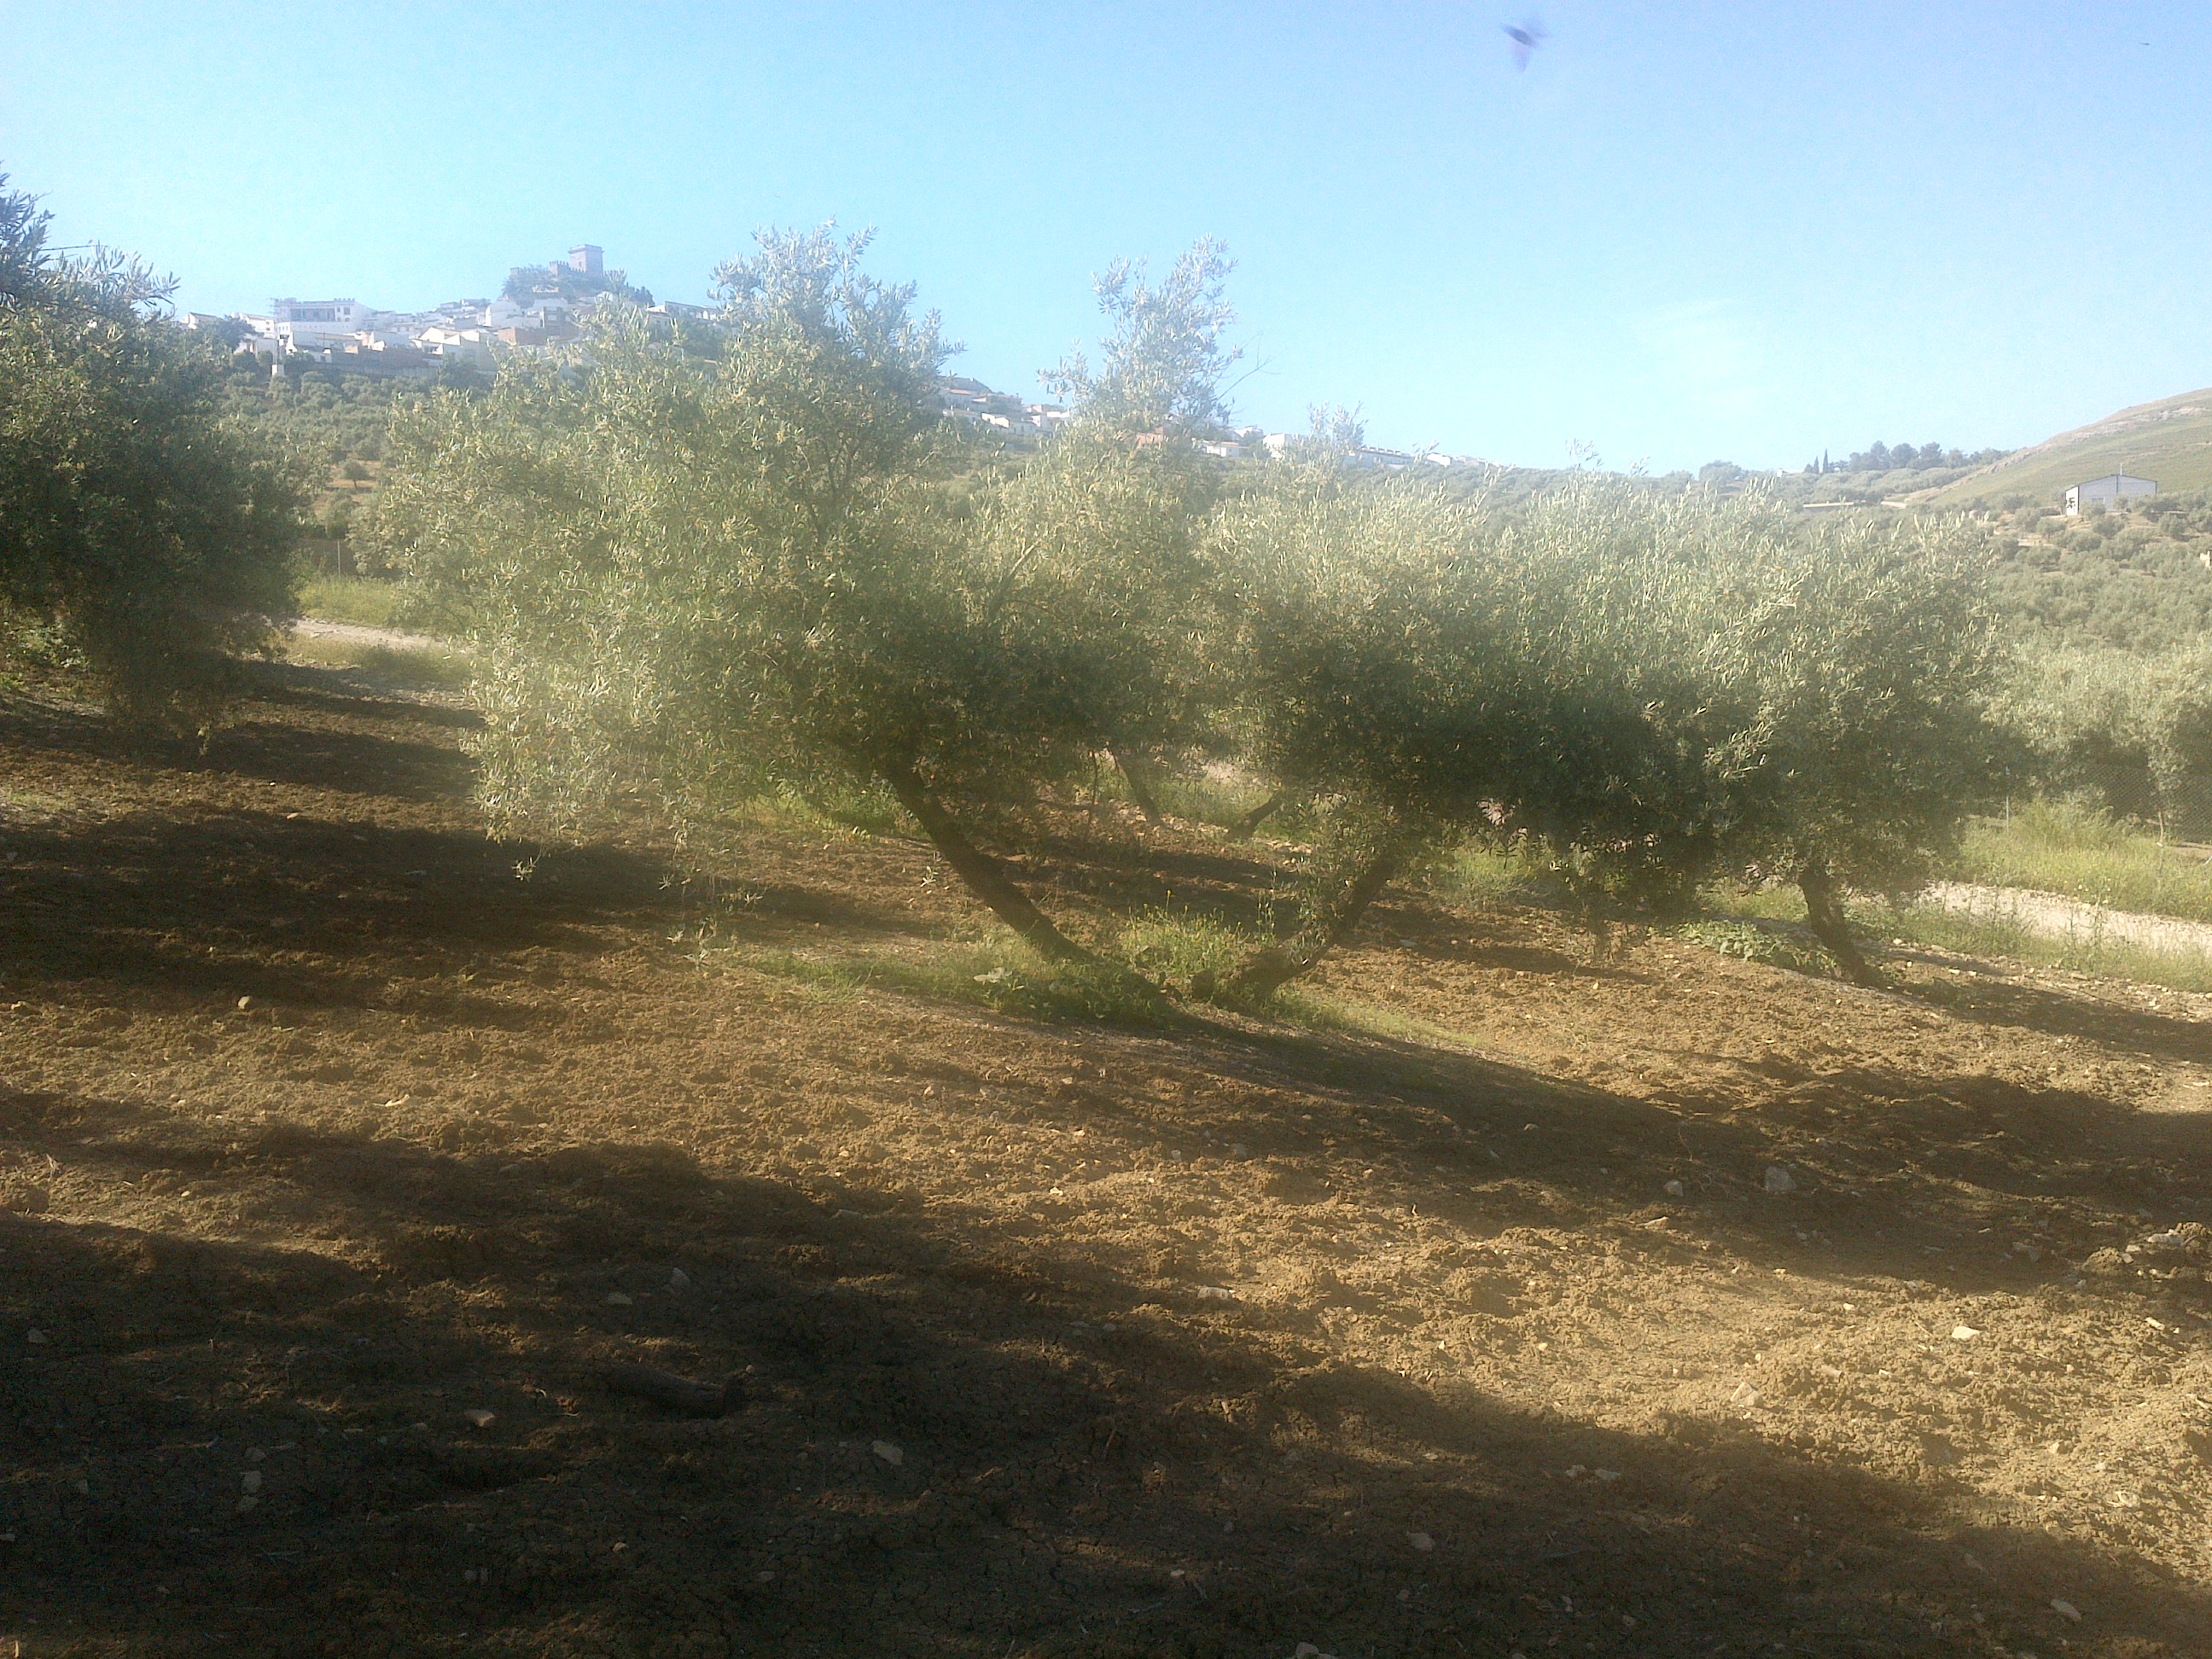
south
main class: Cropland
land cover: Olive groves
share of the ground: 50 - 75 %
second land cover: Other bare soil
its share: > 75 %
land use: Agriculture (excluding fallow land and kitchen gardens)
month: May
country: ES
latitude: 37.6874
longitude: -4.5573
